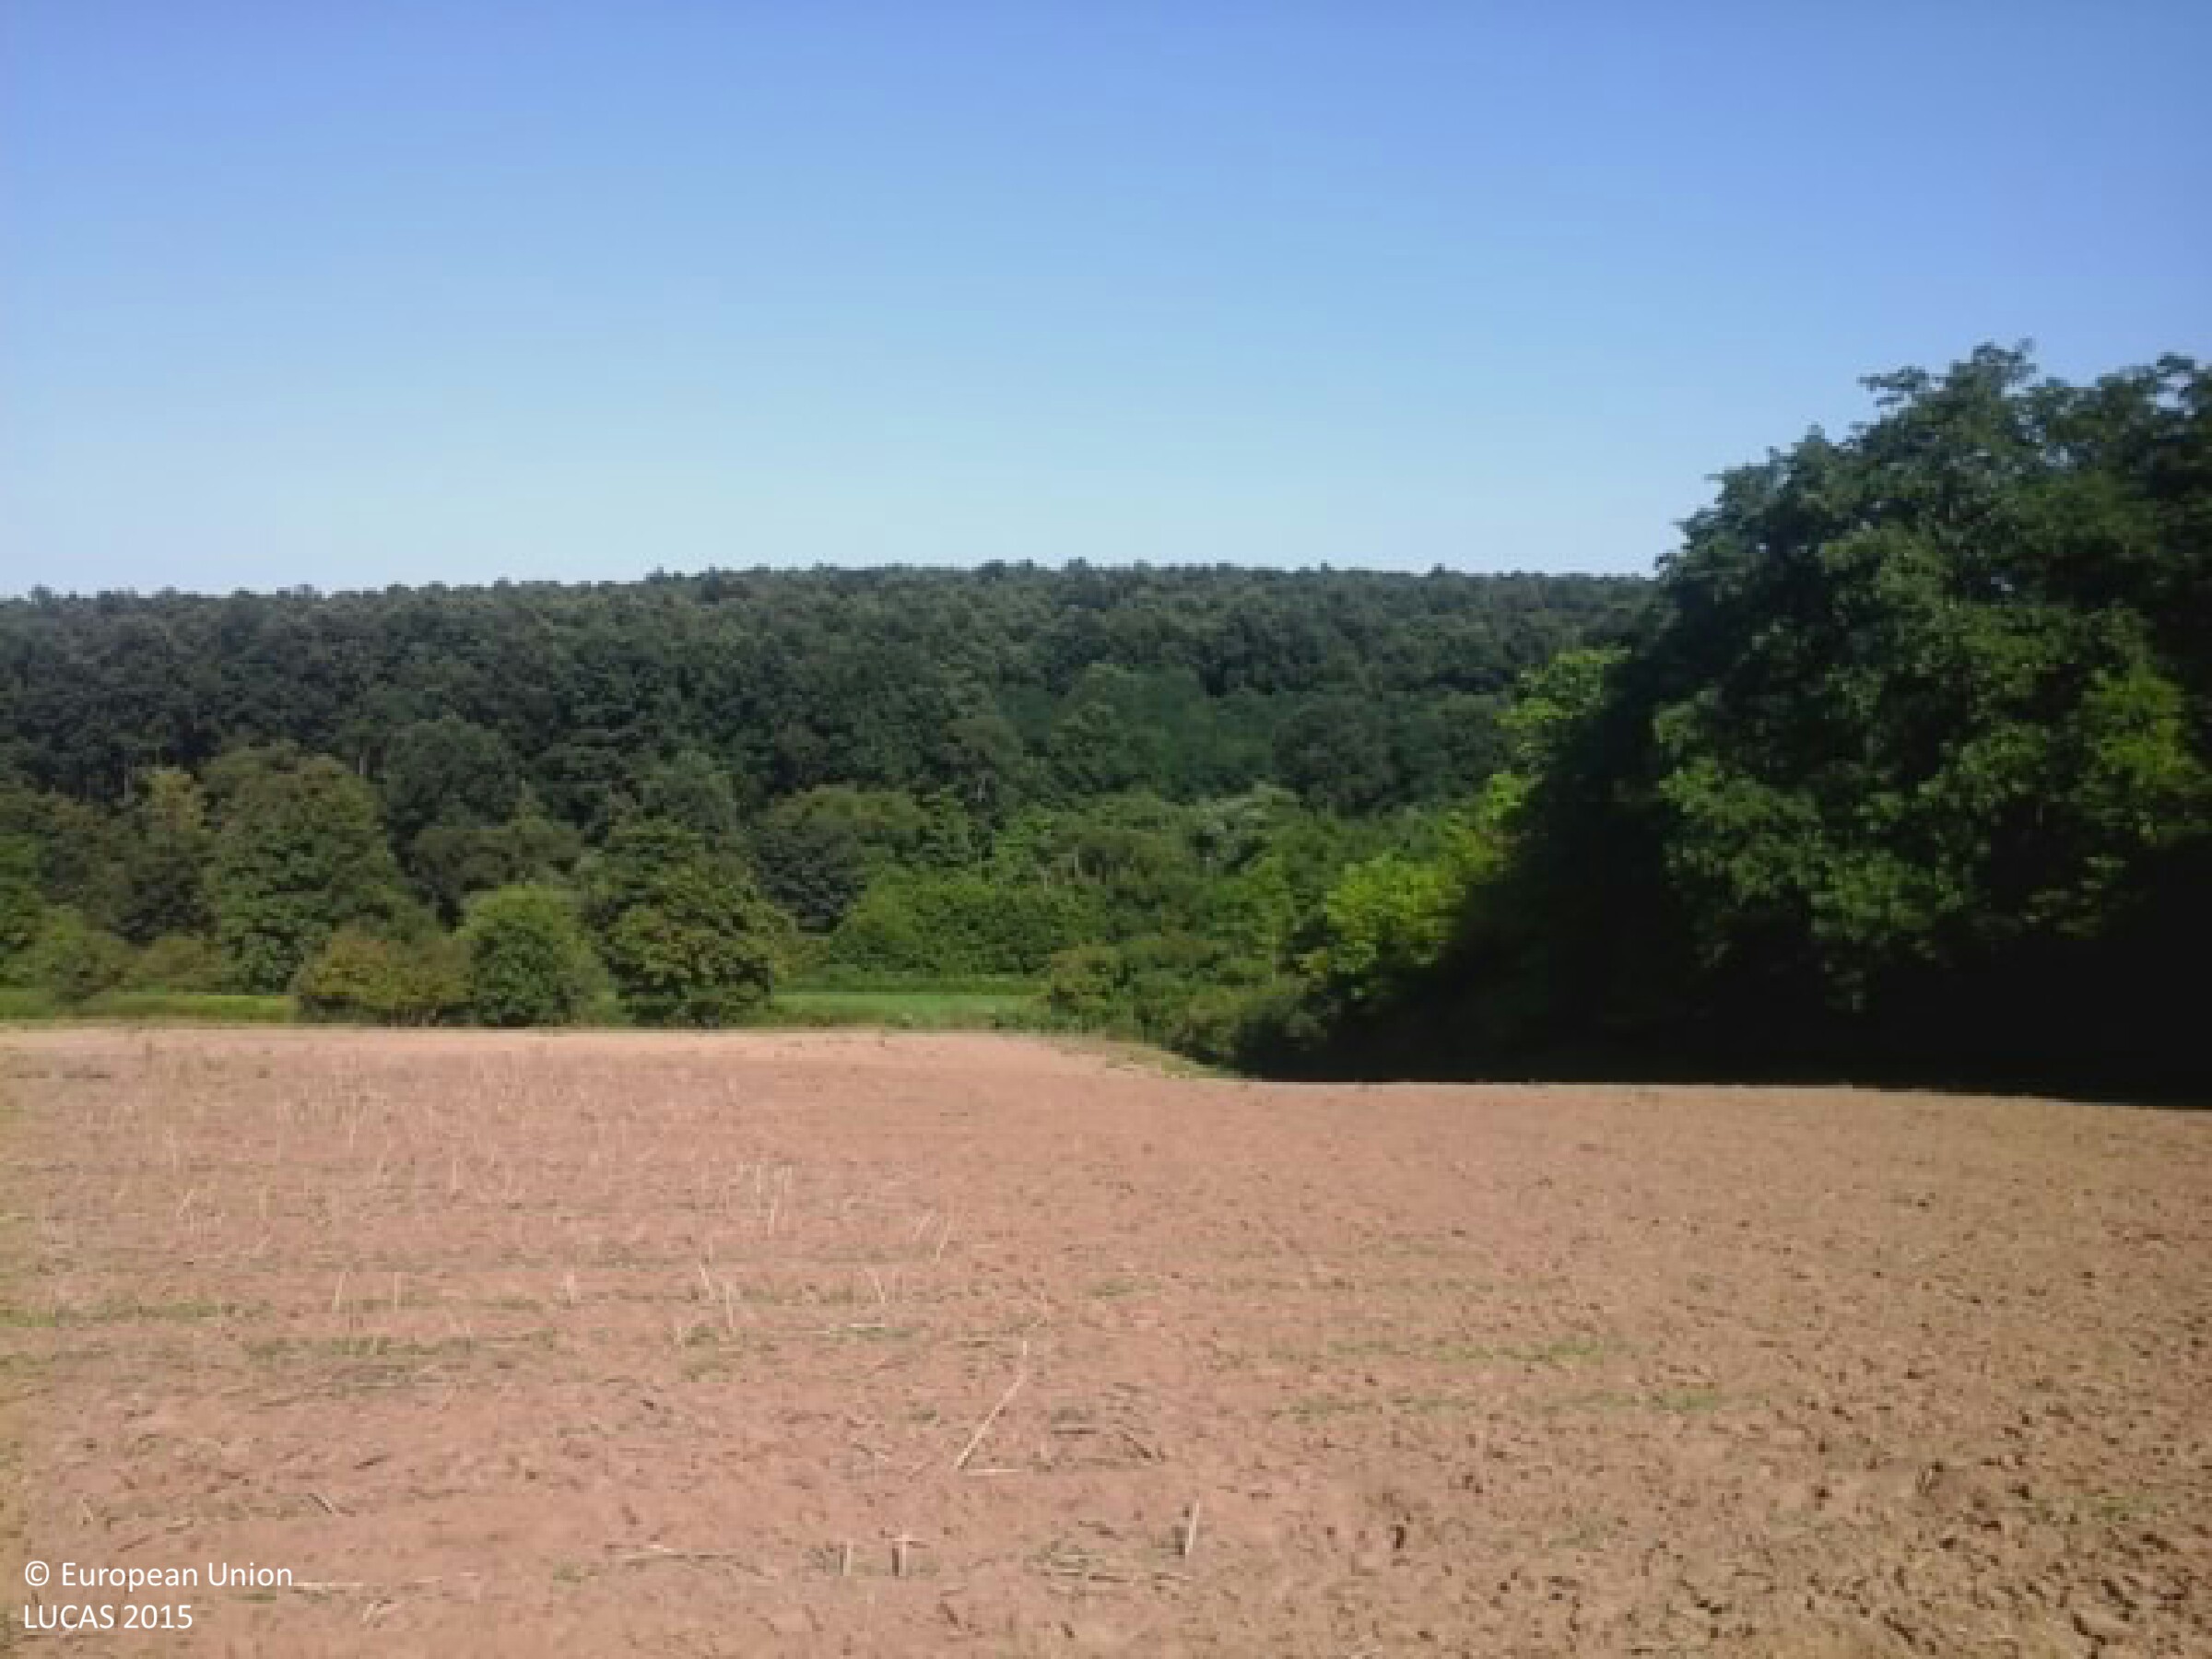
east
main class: Cropland
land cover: Common wheat
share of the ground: < 10 %
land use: Agriculture (excluding fallow land and kitchen gardens)
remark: Harvested field
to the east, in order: Common wheat; Shruby margins; Maize; Ditches and canals; Broadleaved woodland
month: July
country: HU
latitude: 46.4853
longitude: 17.7570
